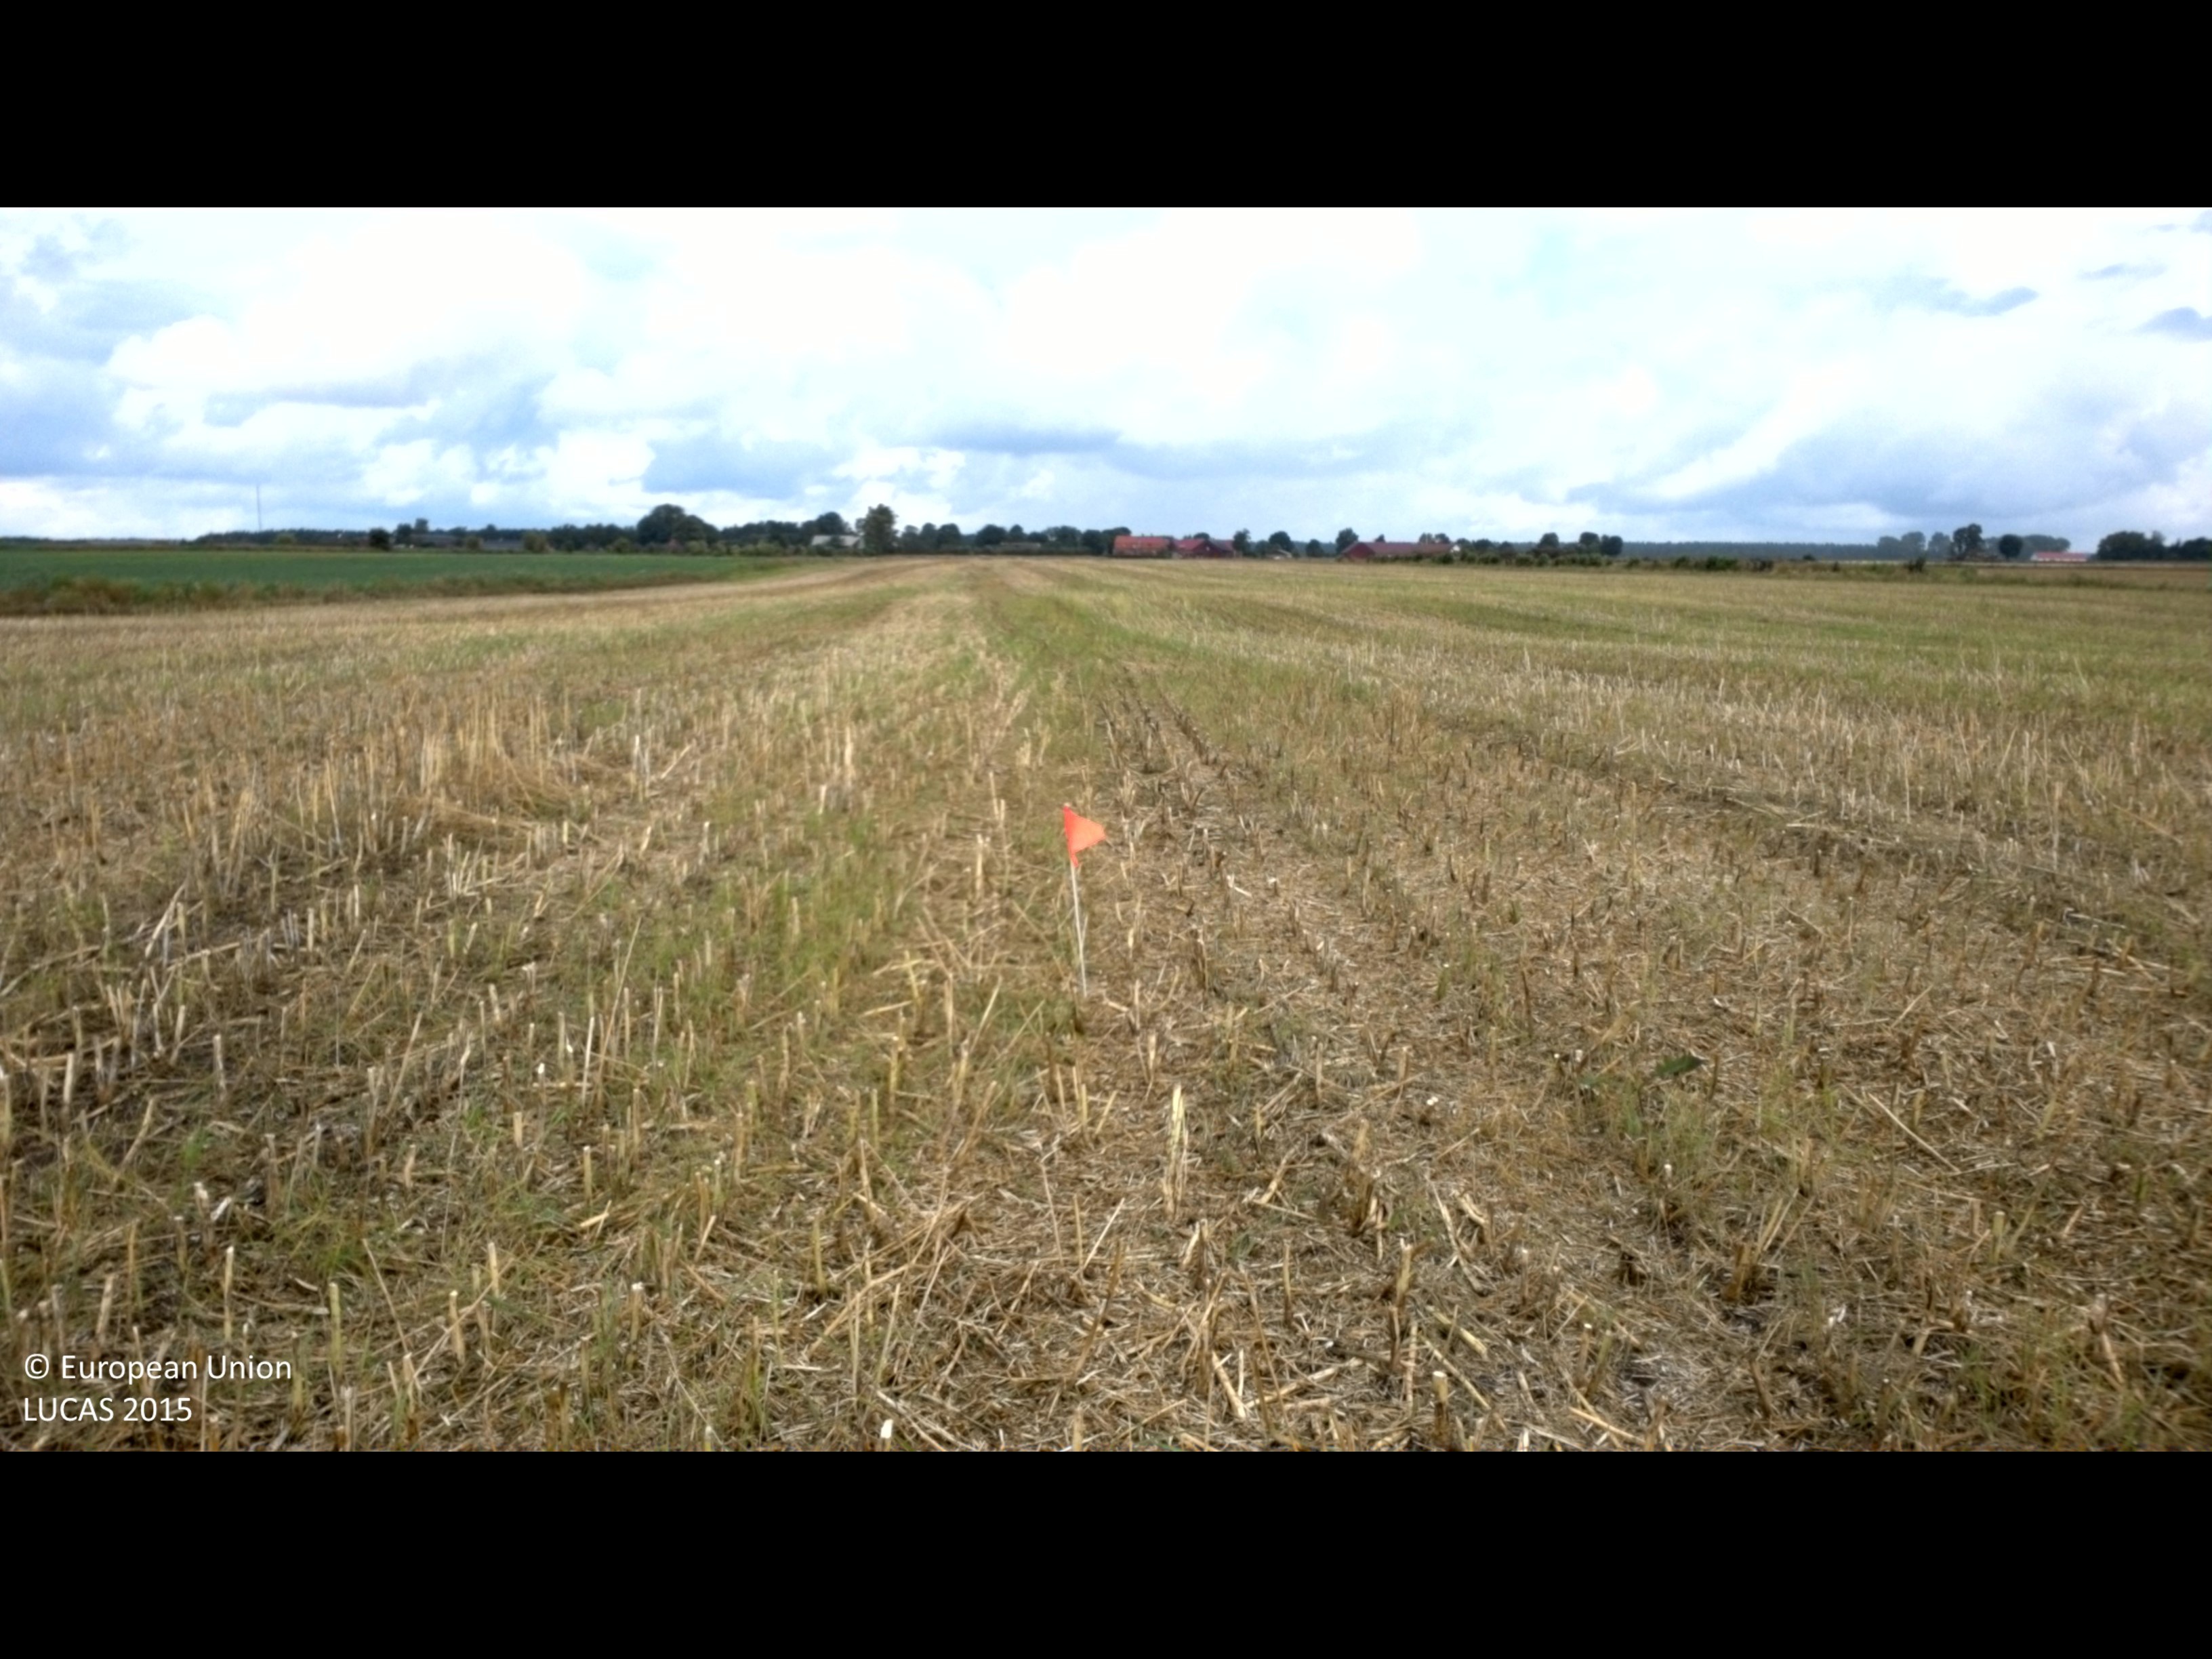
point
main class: Cropland
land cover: Rape and turnip rape
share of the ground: 10 - 25 %
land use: Agriculture (excluding fallow land and kitchen gardens)
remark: Harvested field
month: July
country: SE
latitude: 55.9019
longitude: 14.2366
